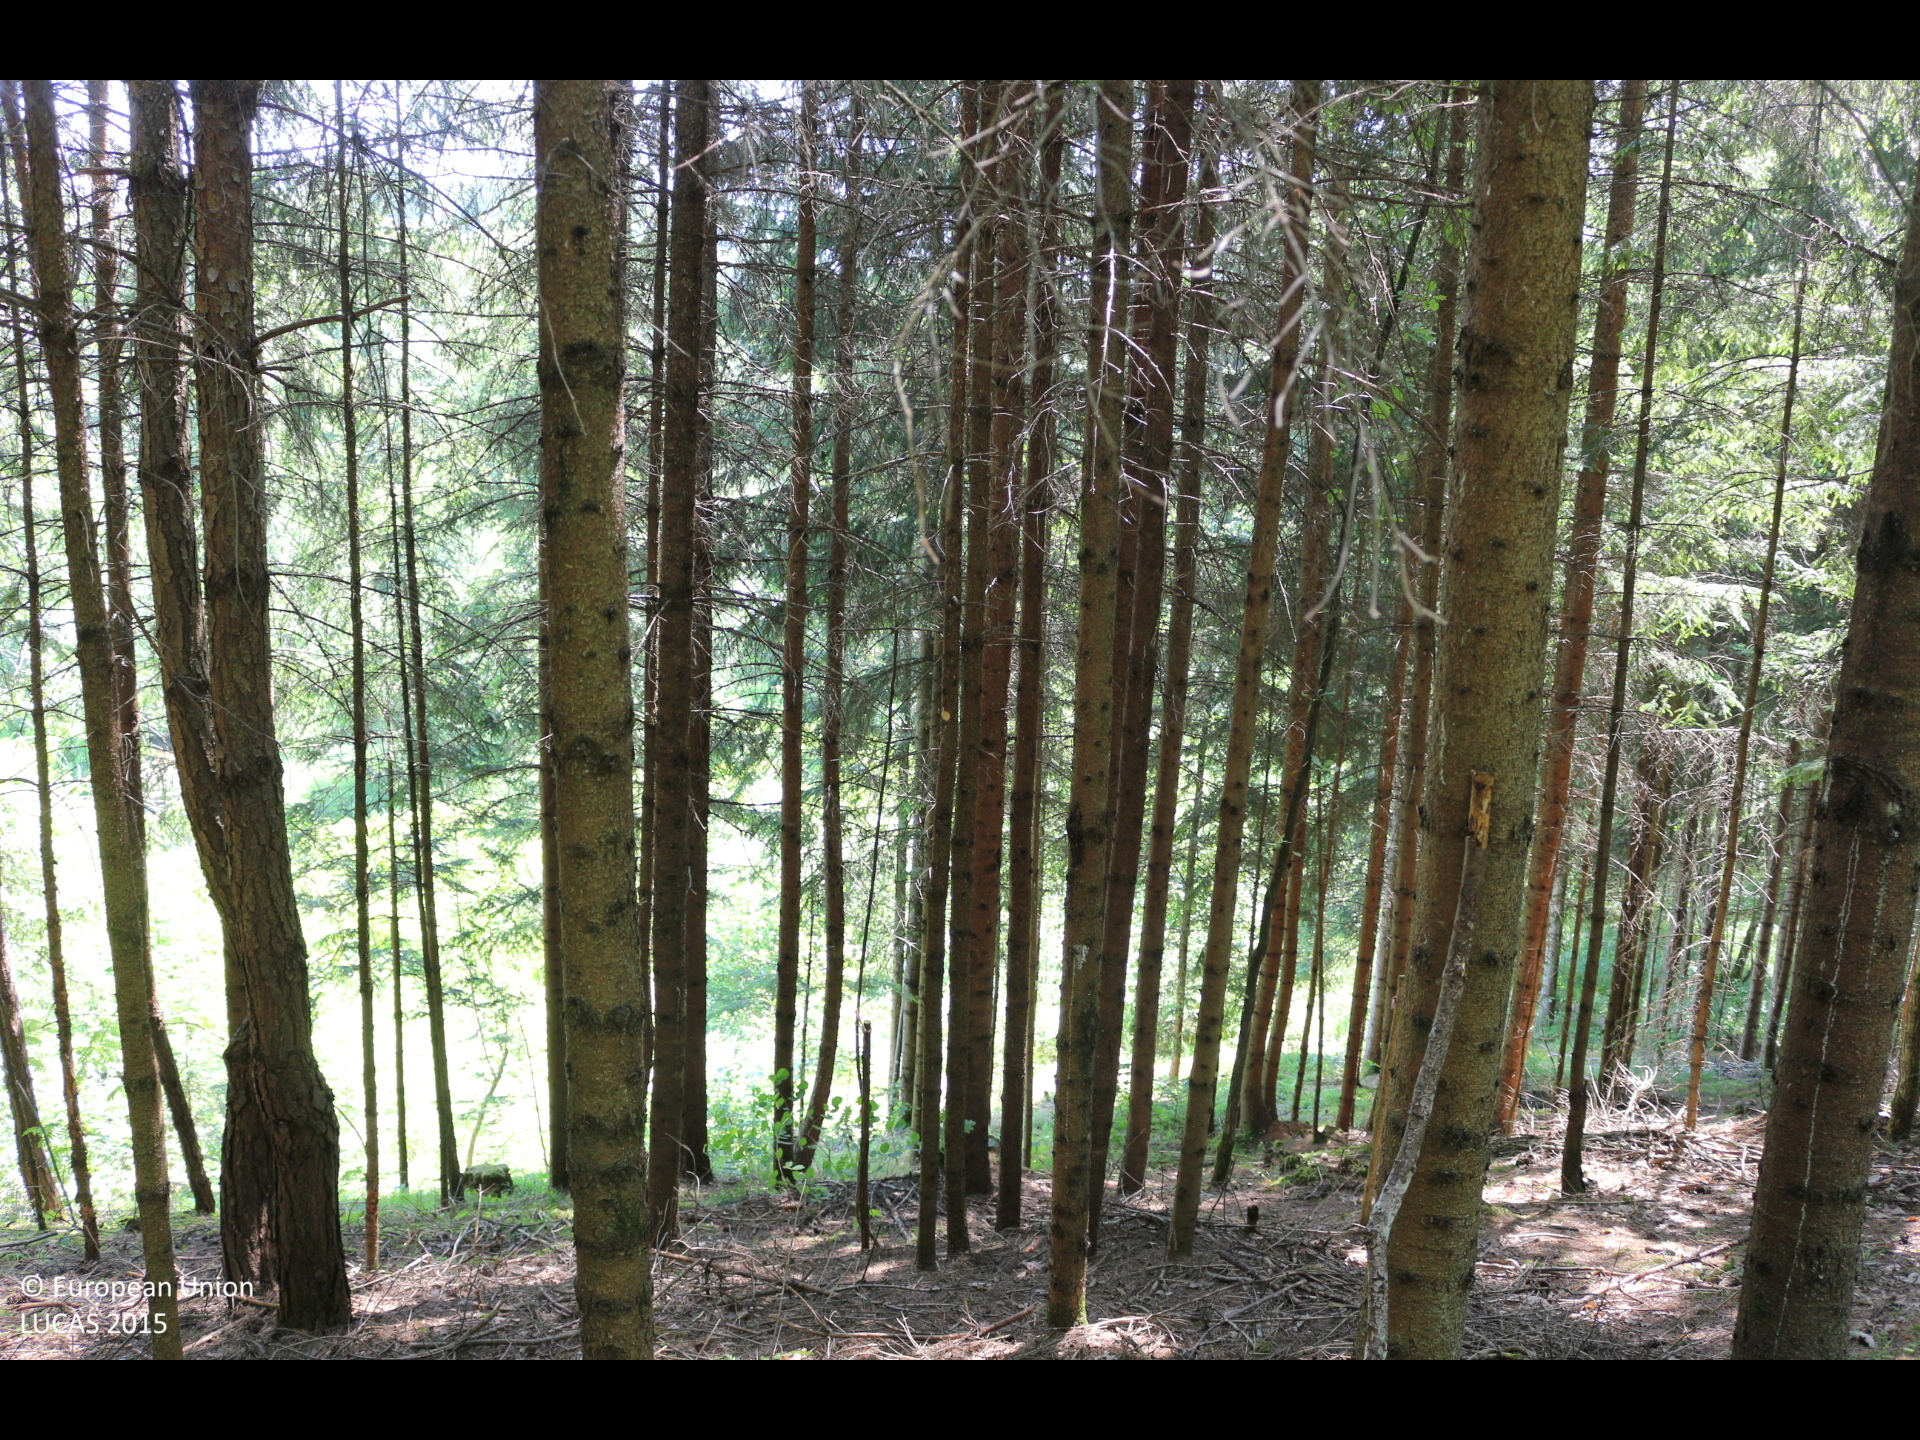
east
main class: Woodland
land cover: Spruce dominated coniferous woodland
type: alpine coniferous forest
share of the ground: > 75 %
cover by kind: coniferous forest trees 90 %, broadleaved forest trees 10 %
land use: Forestry
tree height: > 5 m
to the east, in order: Spruce dominated coniferous woodland; Inland marshes; Rivers and streams; Broadleaved woodland; Grassland without tree/shrub cover; Paved roads, cycling and walking lanes; Grassland without tree/shrub cover; Broadleaved woodland; Rivers and streams; Broadleaved woodland; Grassland without tree/shrub cover
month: June
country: AT
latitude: 46.7047
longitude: 14.1175
